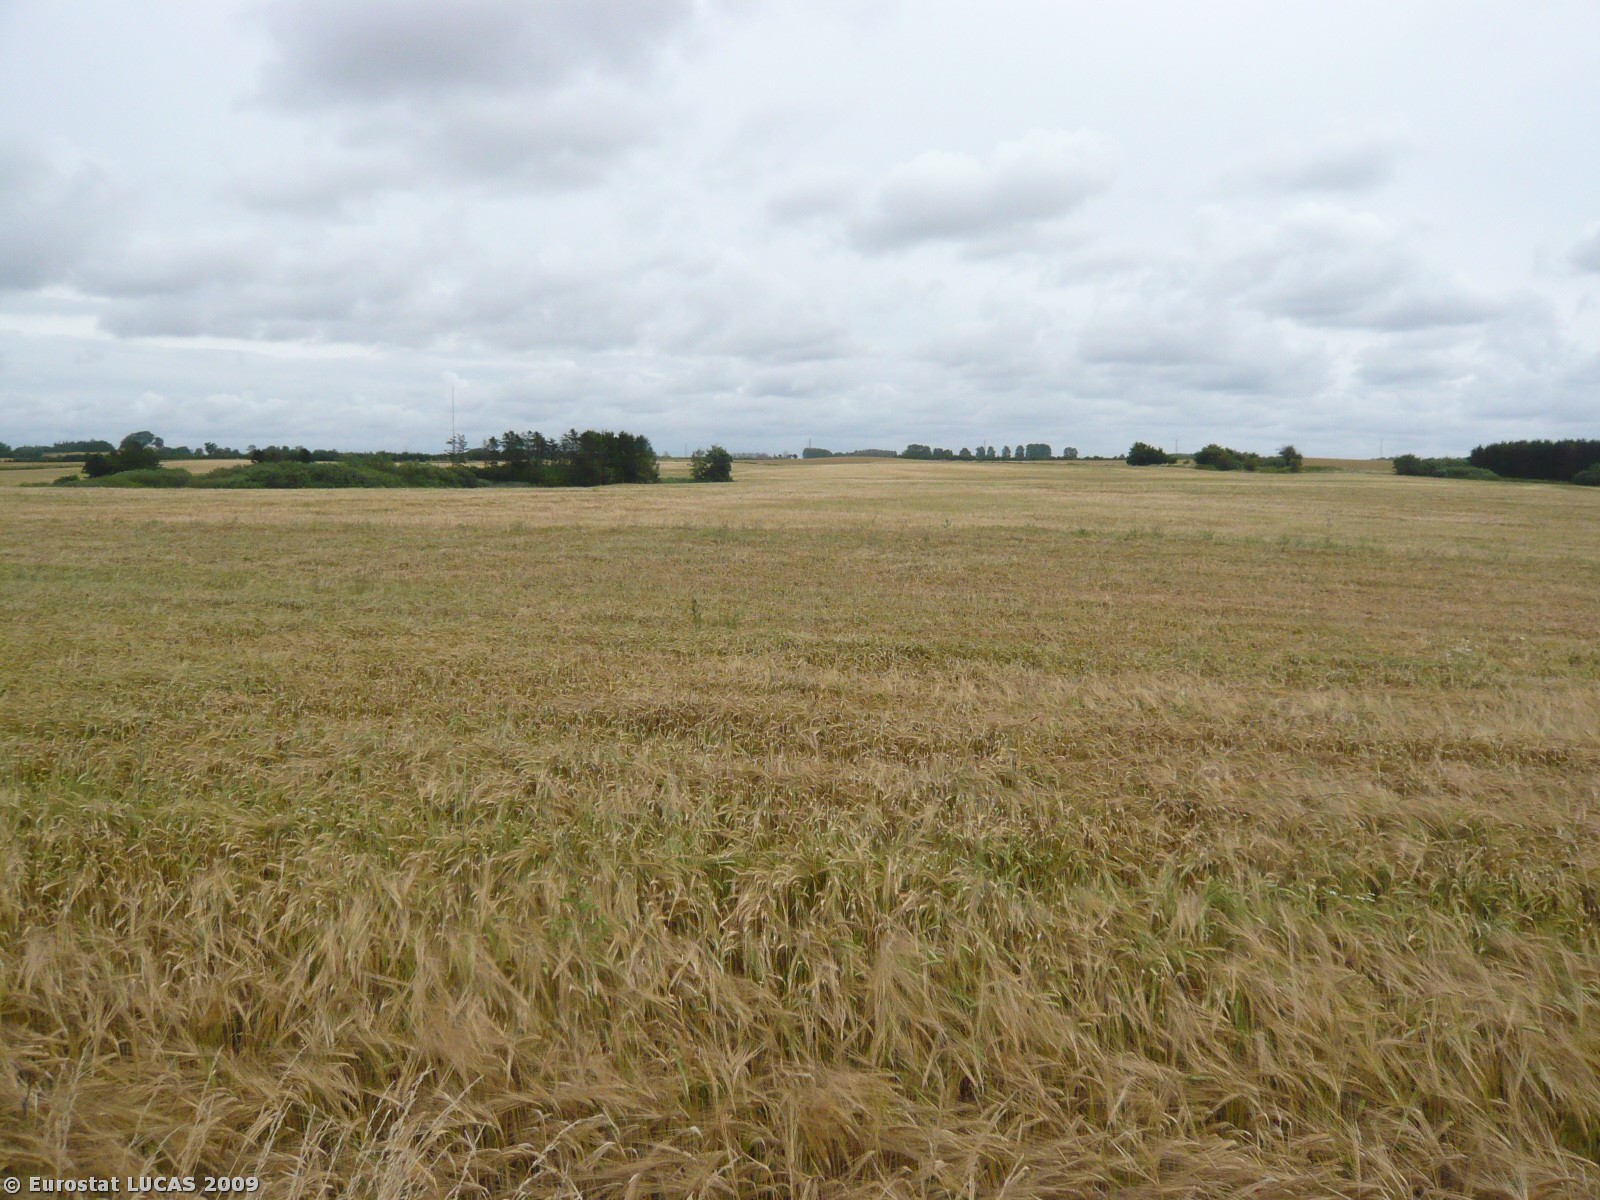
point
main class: Cropland
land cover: Barley
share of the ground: > 75 %
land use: Agriculture (excluding fallow land and kitchen gardens)
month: July
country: DK
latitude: 55.6838
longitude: 12.1771
